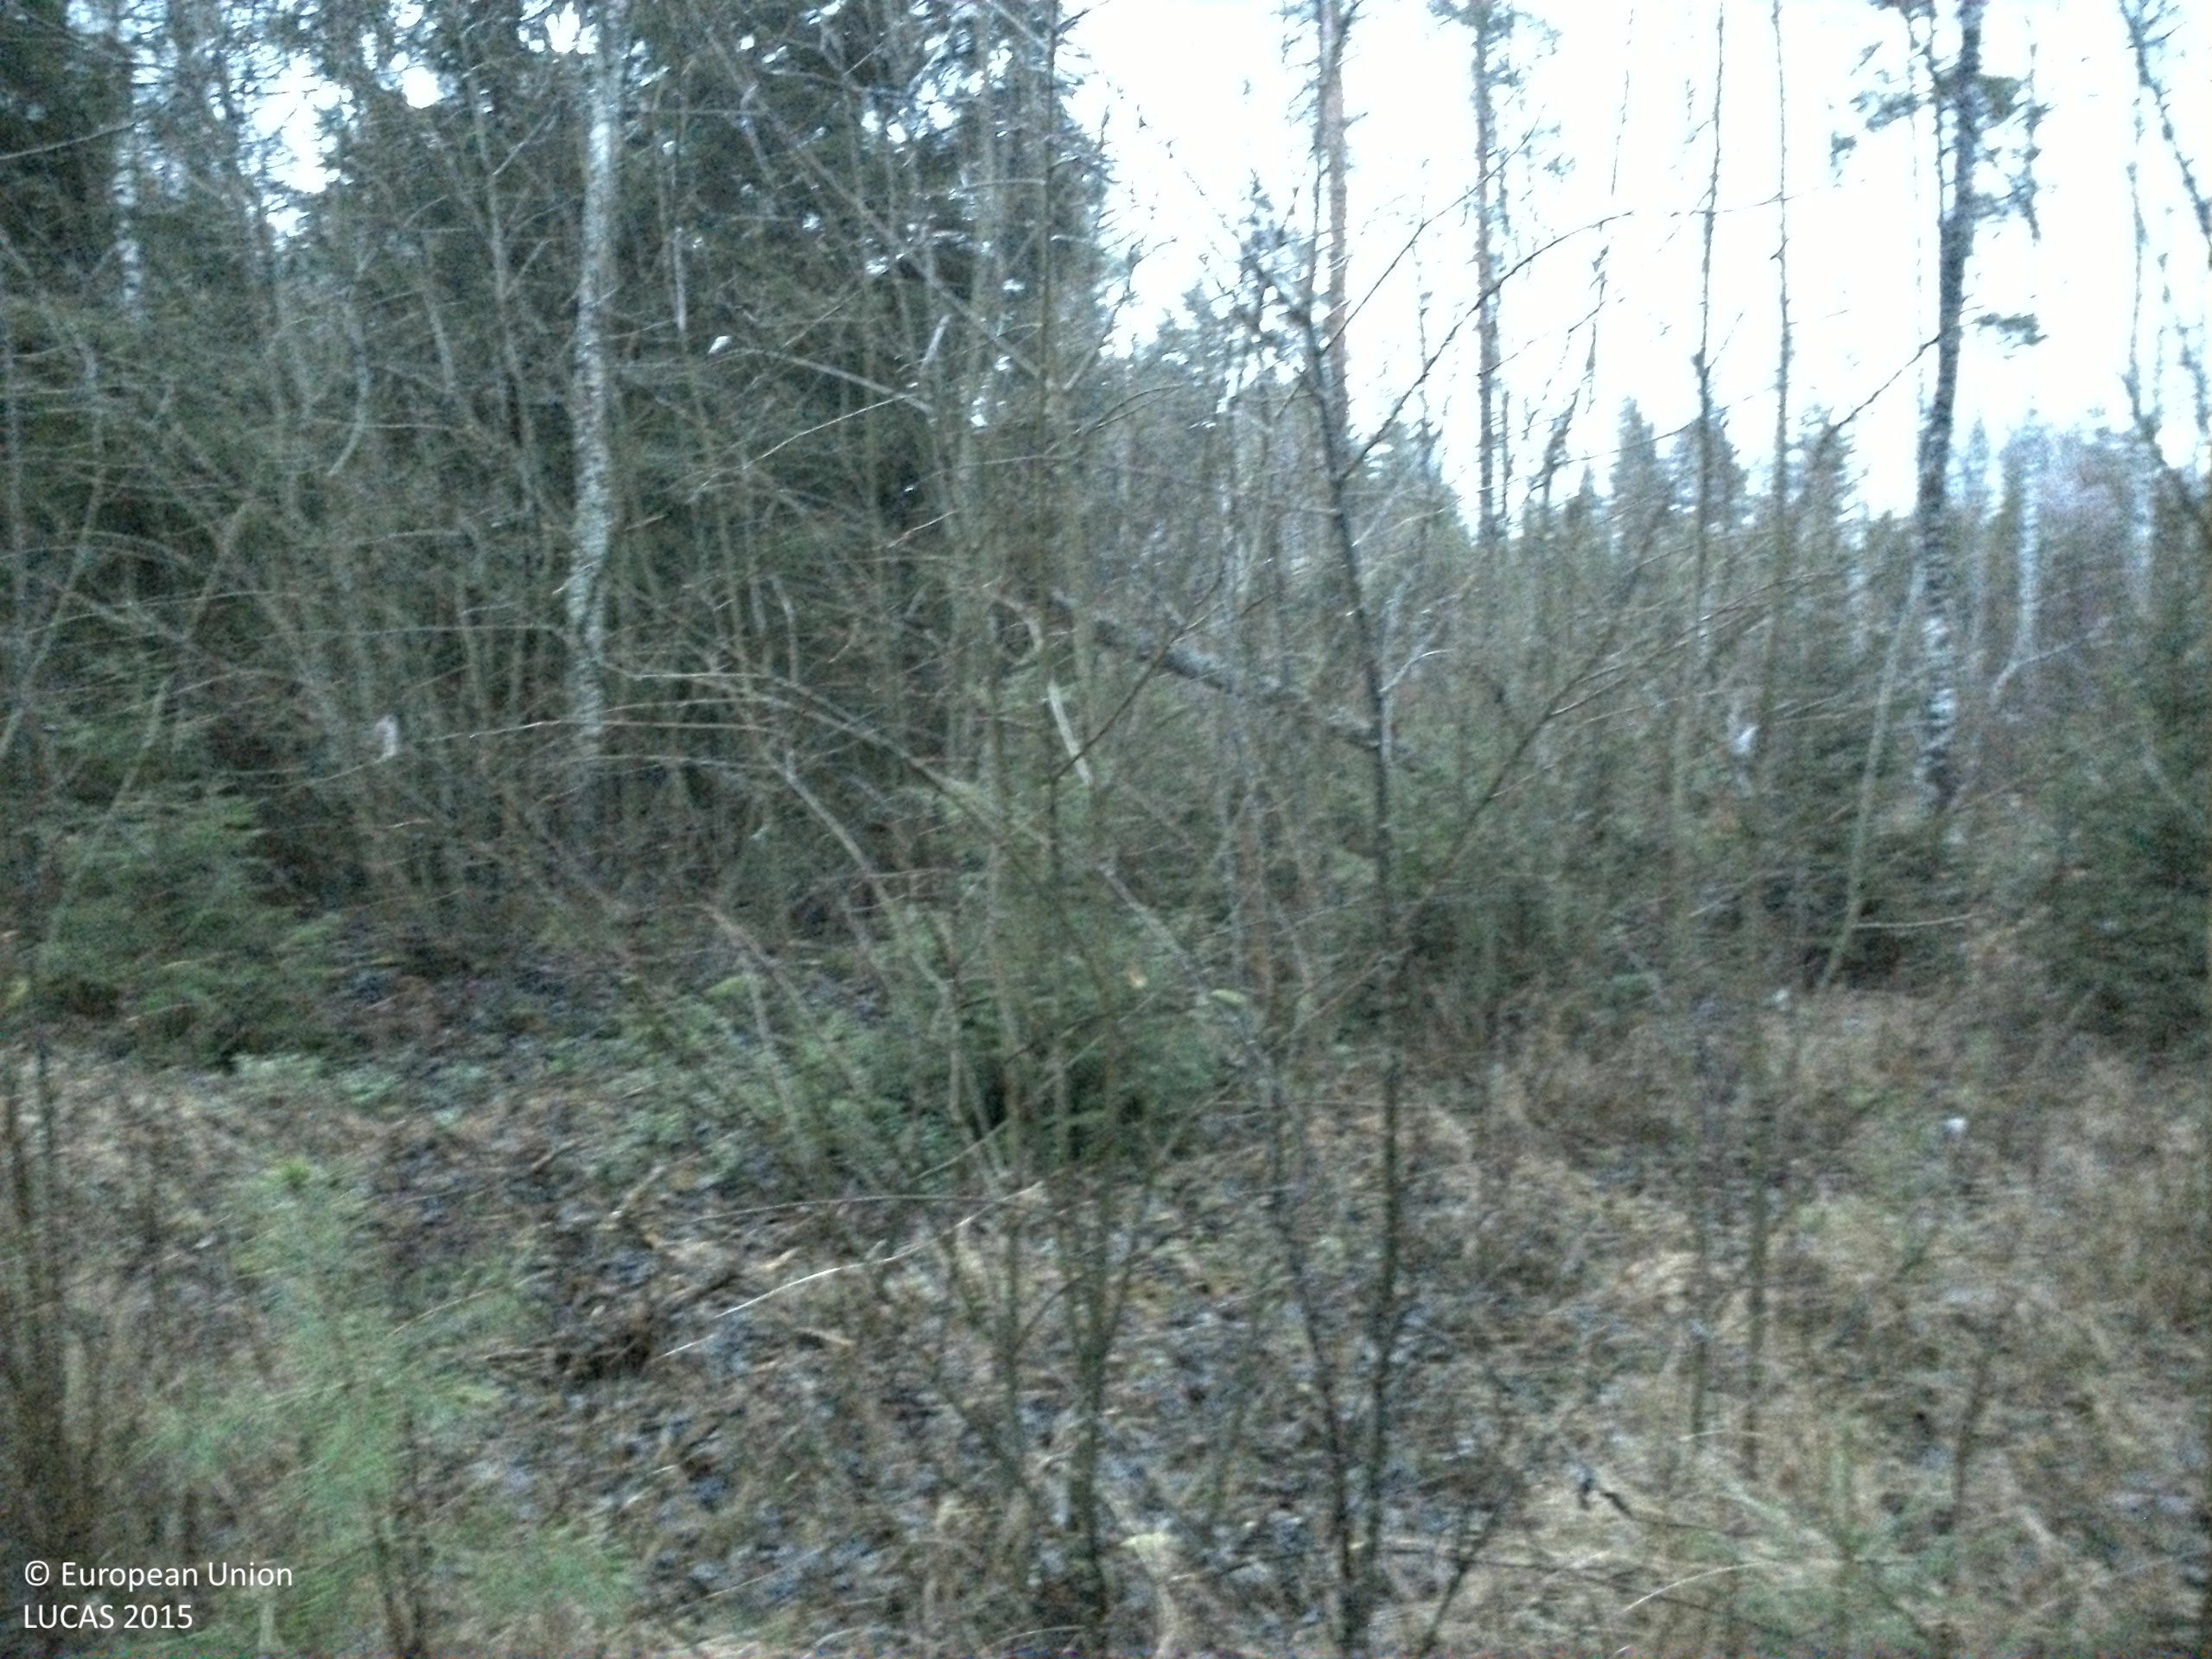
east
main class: Woodland
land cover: Pine dominated mixed woodland
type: boreal forest
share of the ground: 50 - 75 %
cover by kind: broadleaved forest trees 40 %, coniferous forest trees 20 %, herbaceous plants 20 %, consolidated bare surface 15 %, lichens and mosses 5 %
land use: Forestry
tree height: > 5 m
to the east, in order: Pine dominated mixed woodland; Spruce dominated mixed woodland; Spruce dominated coniferous woodland; Spruce dominated mixed woodland; Pine dominated mixed woodland; Pine dominated coniferous woodland; Spruce dominated mixed woodland; Other coniferous woodland; Pine dominated coniferous woodland; Pine dominated mixed woodland; Ditches and canals; Grassland without tree/shrub cover
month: December
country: SE
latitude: 59.3027
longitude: 16.2272
